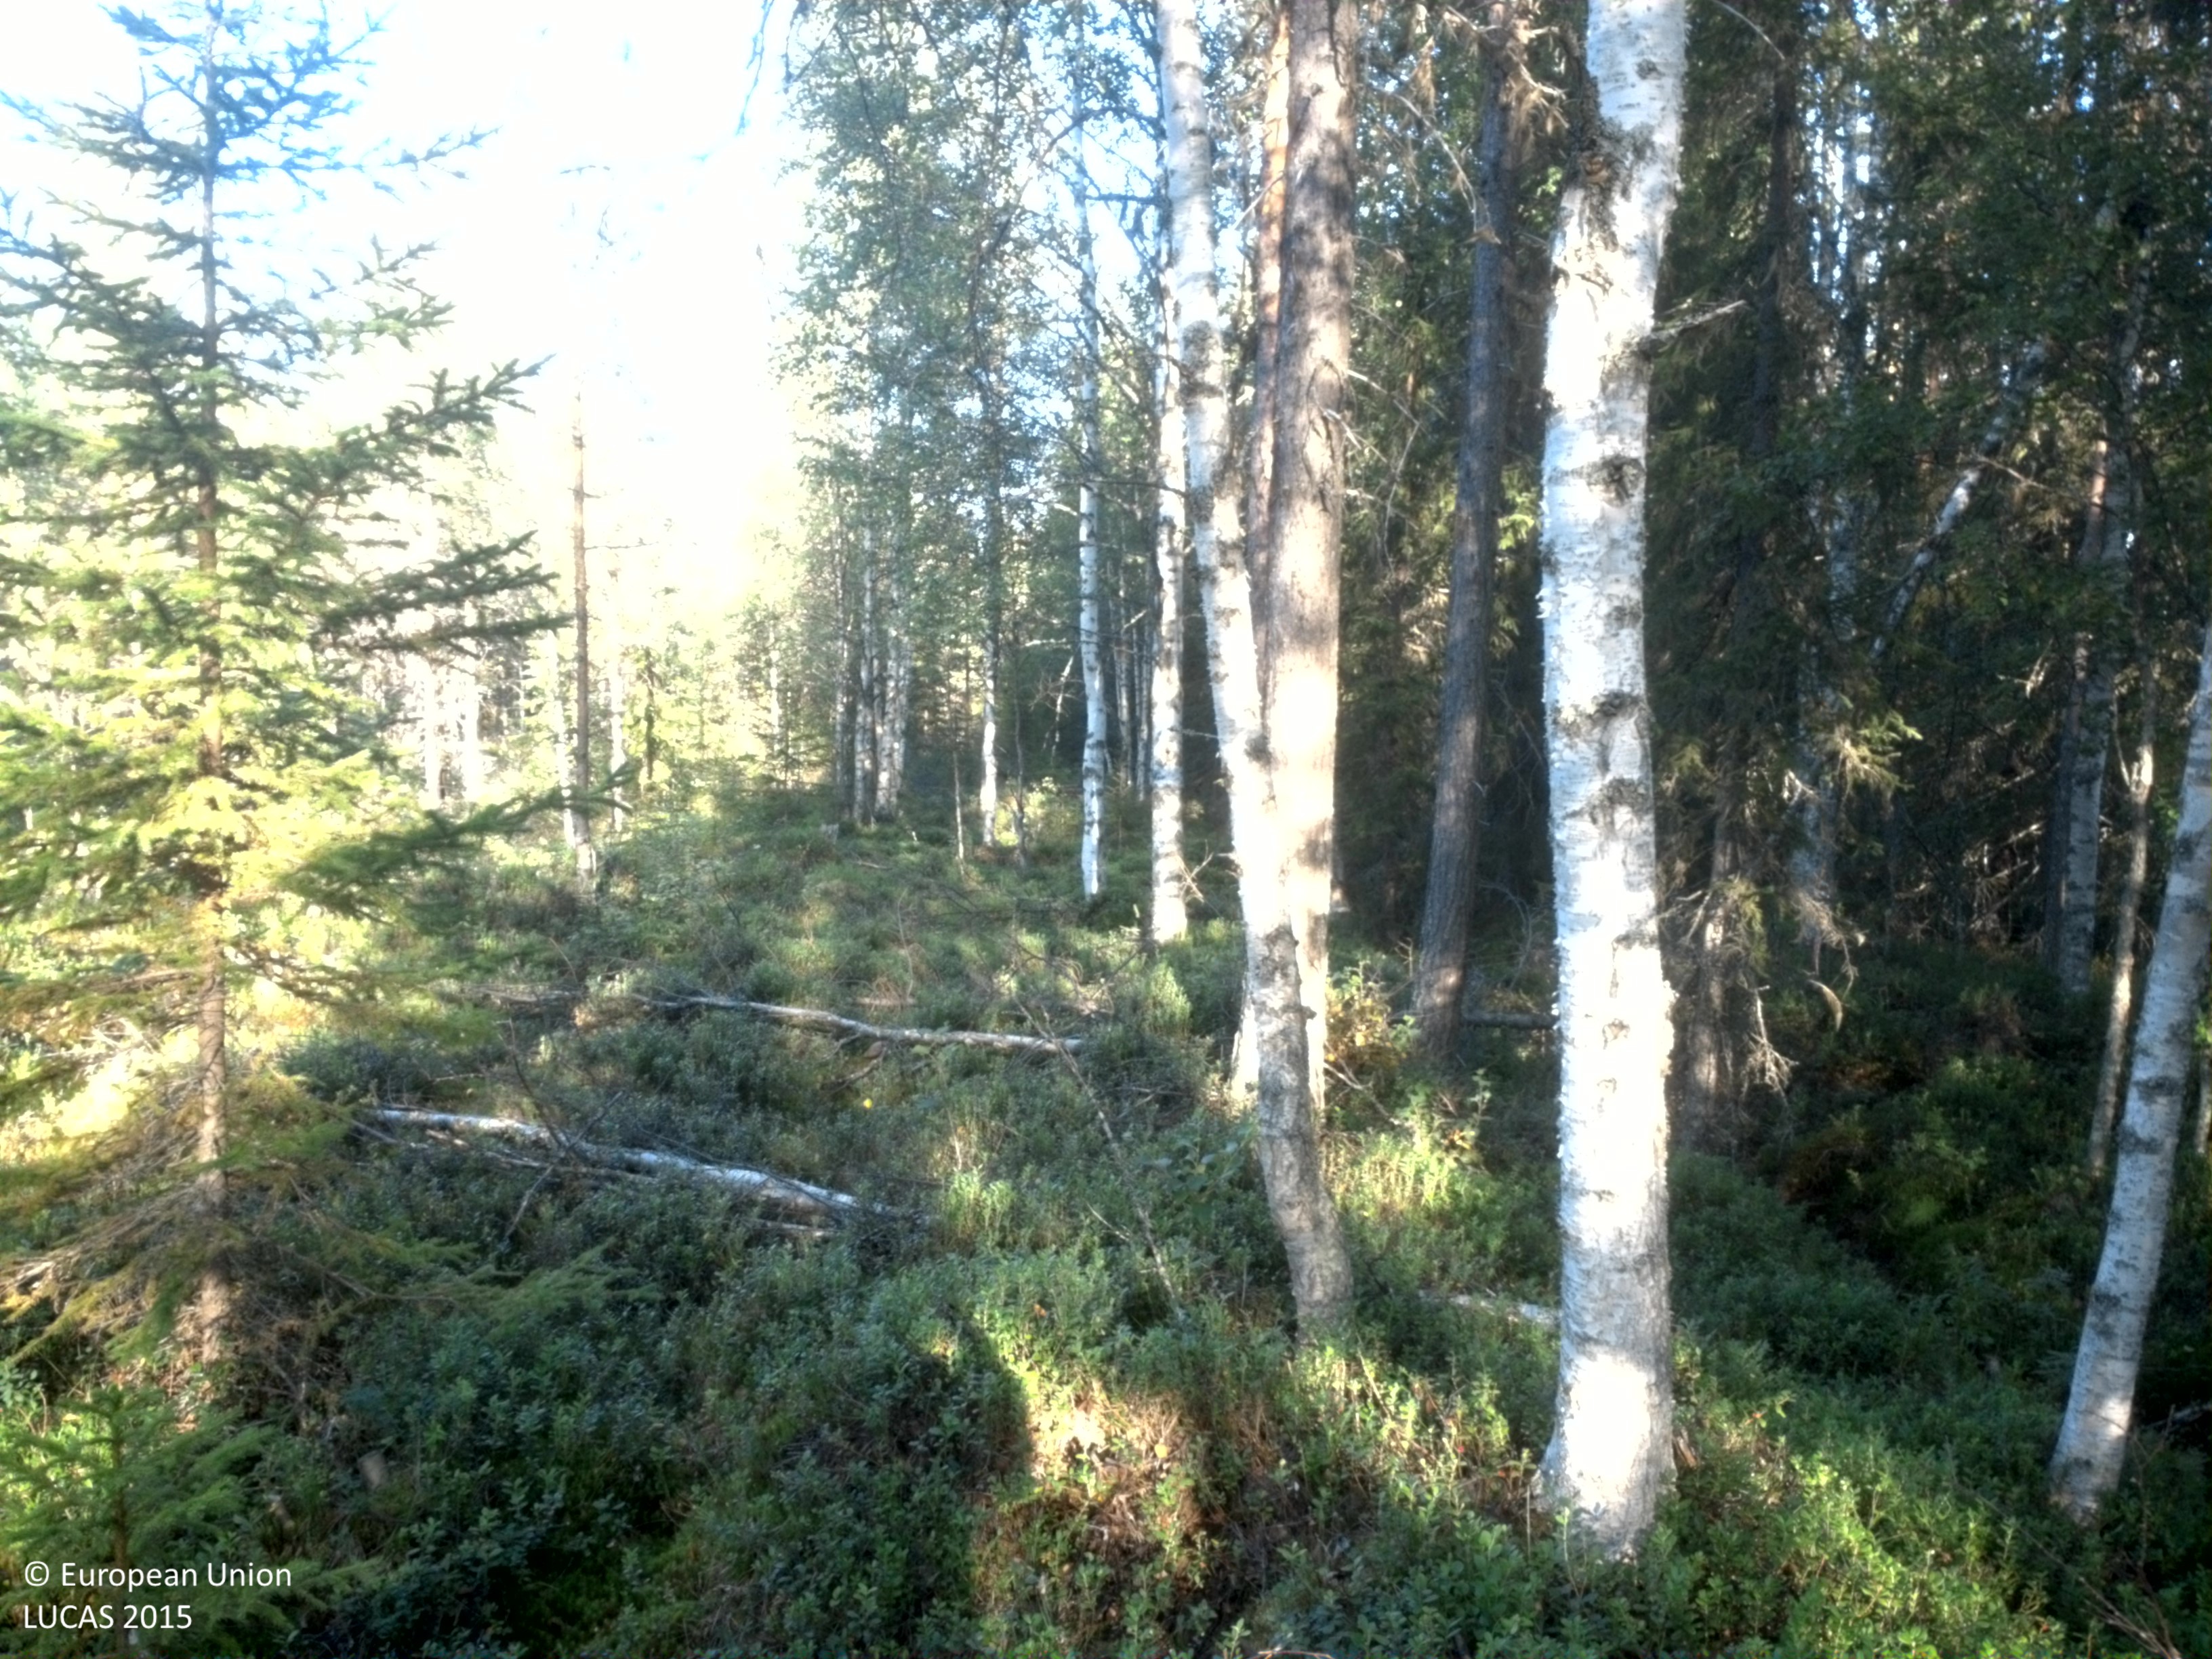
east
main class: Woodland
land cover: Pine dominated mixed woodland
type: boreal forest
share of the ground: 50 - 75 %
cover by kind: coniferous forest trees 45 %, shrubs 35 %, broadleaved forest trees 15 %, lichens and mosses 5 %
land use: Forestry
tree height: > 5 m
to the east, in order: Pine dominated mixed woodland; Ditches and canals; Spruce dominated coniferous woodland; Spruce dominated mixed woodland; Ditches and canals; Broadleaved woodland; Ditches and canals; Broadleaved woodland; Ditches and canals; Pine dominated mixed woodland; Pine dominated coniferous woodland
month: August
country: SE
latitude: 64.6165
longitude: 18.3092
